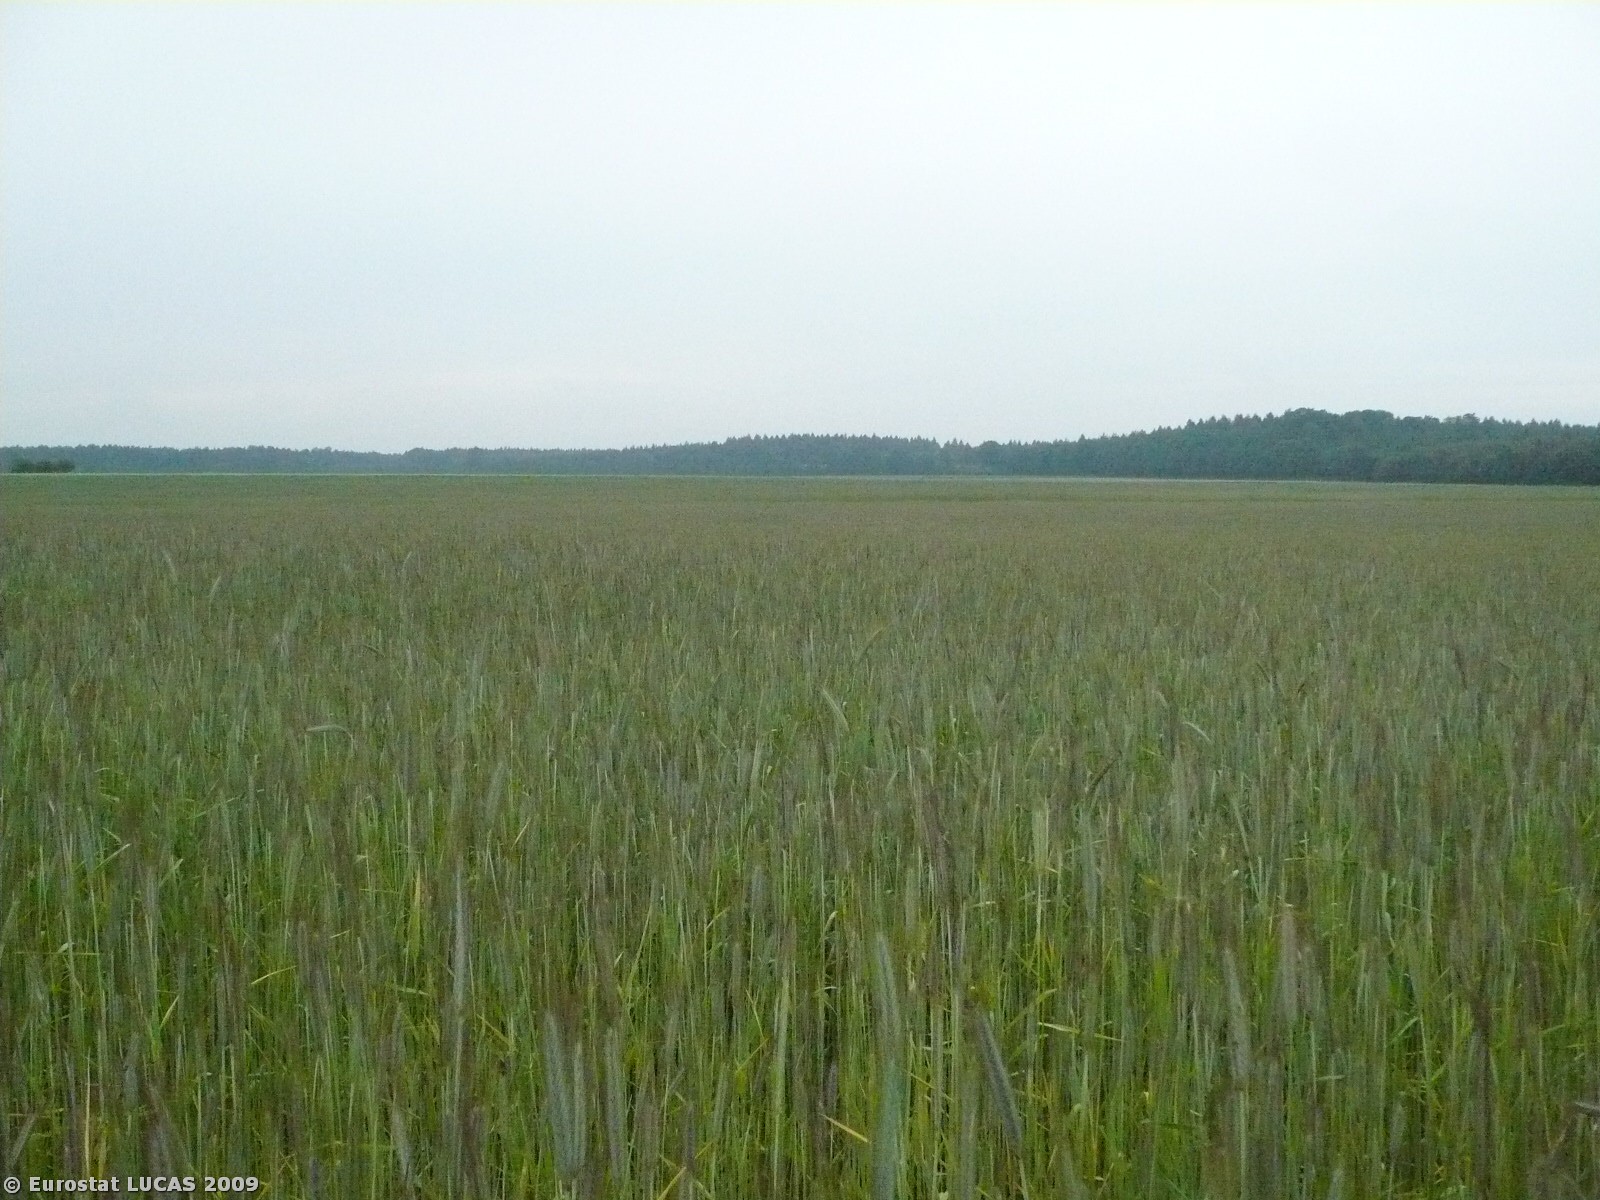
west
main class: Cropland
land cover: Rye
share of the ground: > 75 %
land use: Agriculture (excluding fallow land and kitchen gardens)
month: May
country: PL
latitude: 52.1752
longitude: 16.2800
